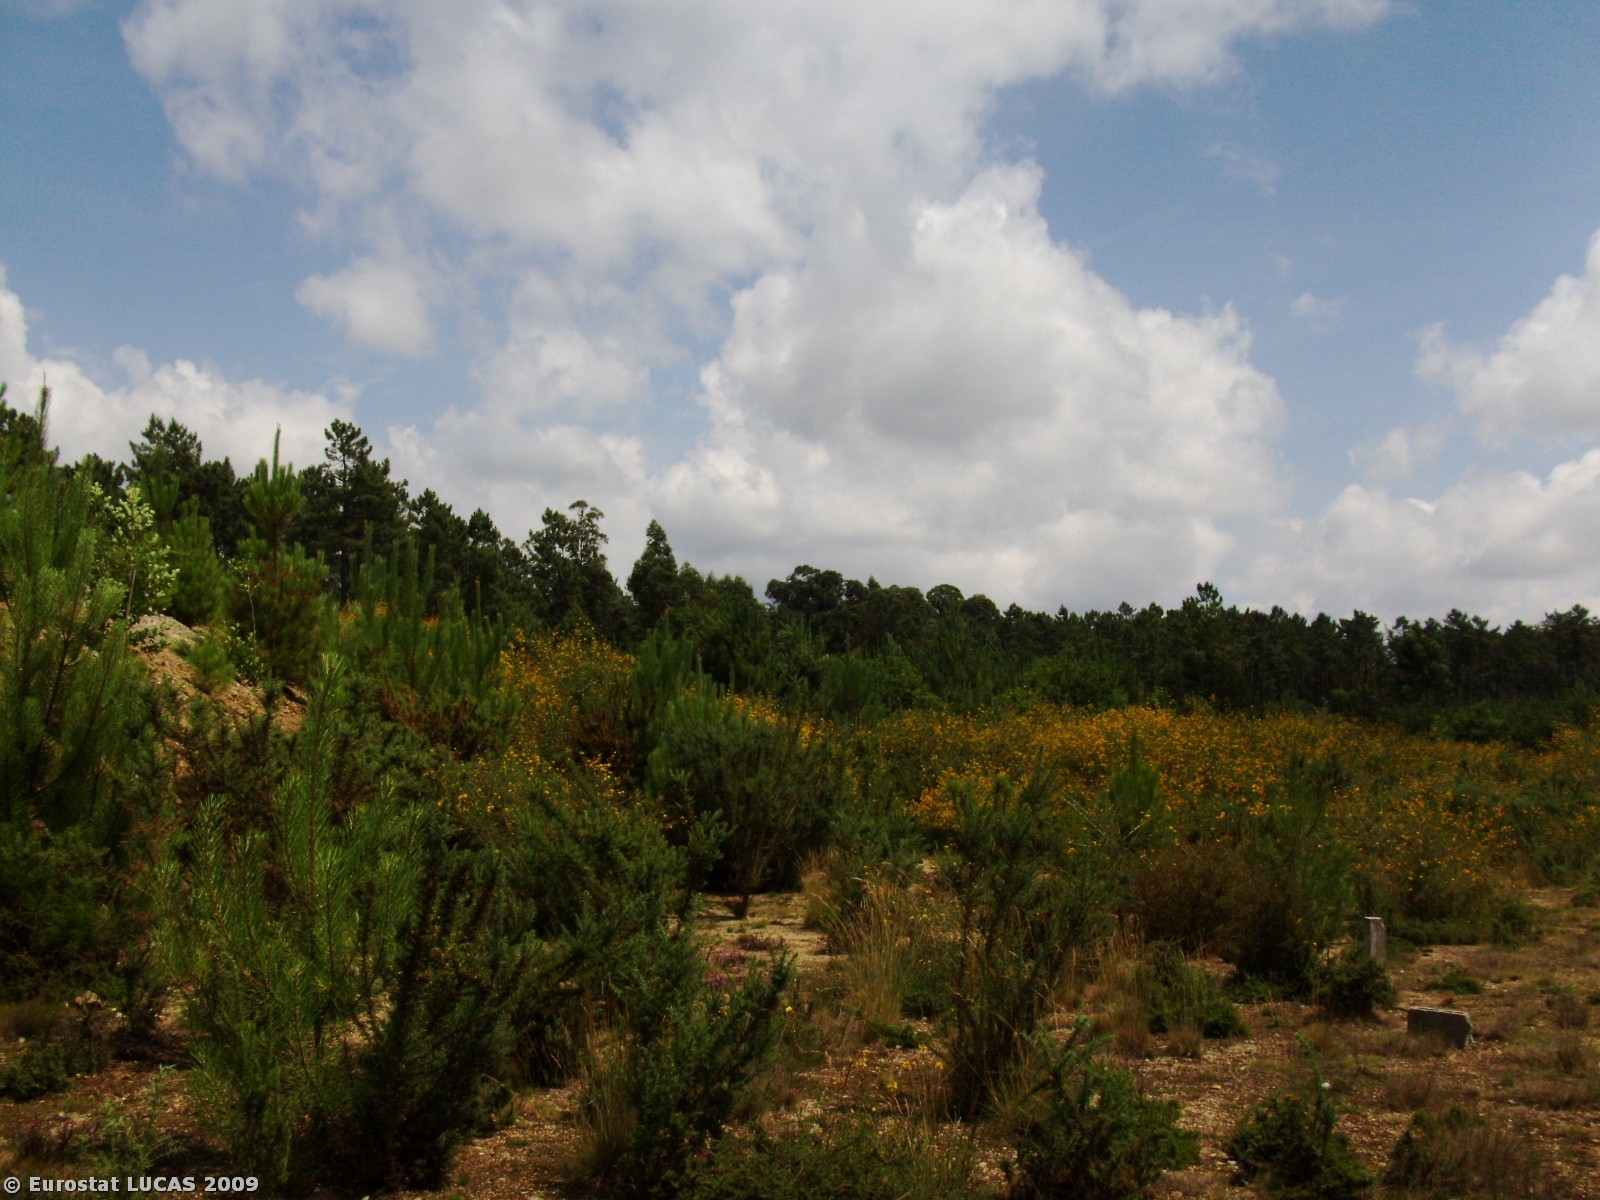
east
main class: Grassland
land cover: Spontaneously vegetated surfaces
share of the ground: 10 - 25 %
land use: Unused
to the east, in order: Spontaneously vegetated surfaces; Paved roads, cycling and walking lanes; Spontaneously vegetated surfaces; Coniferous woodland
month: June
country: PT
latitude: 41.5272
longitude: -8.5782
